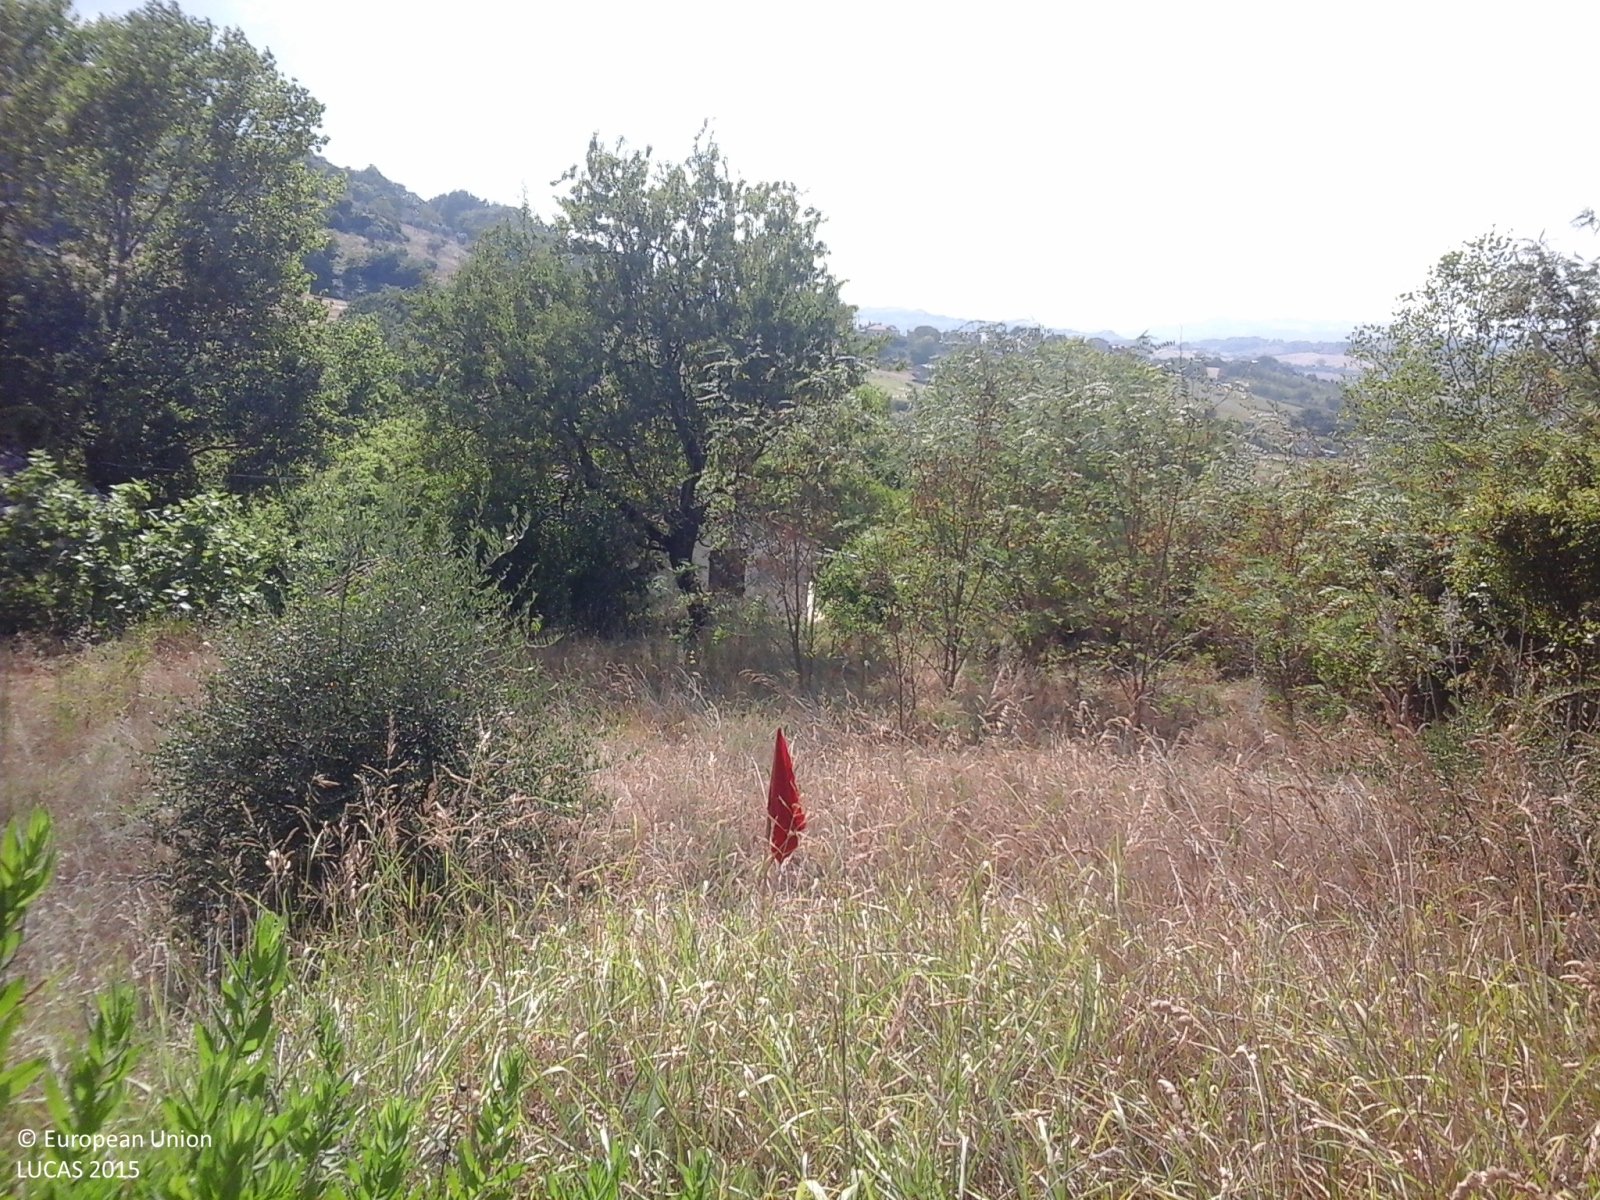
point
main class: Grassland
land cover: Grassland with sparse tree/shrub cover
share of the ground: > 75 %
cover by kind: herbaceous plants 95 %, broadleaved forest trees 5 %
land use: Semi-natural and natural areas not in use
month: July
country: IT
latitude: 43.0947
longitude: 13.6392
